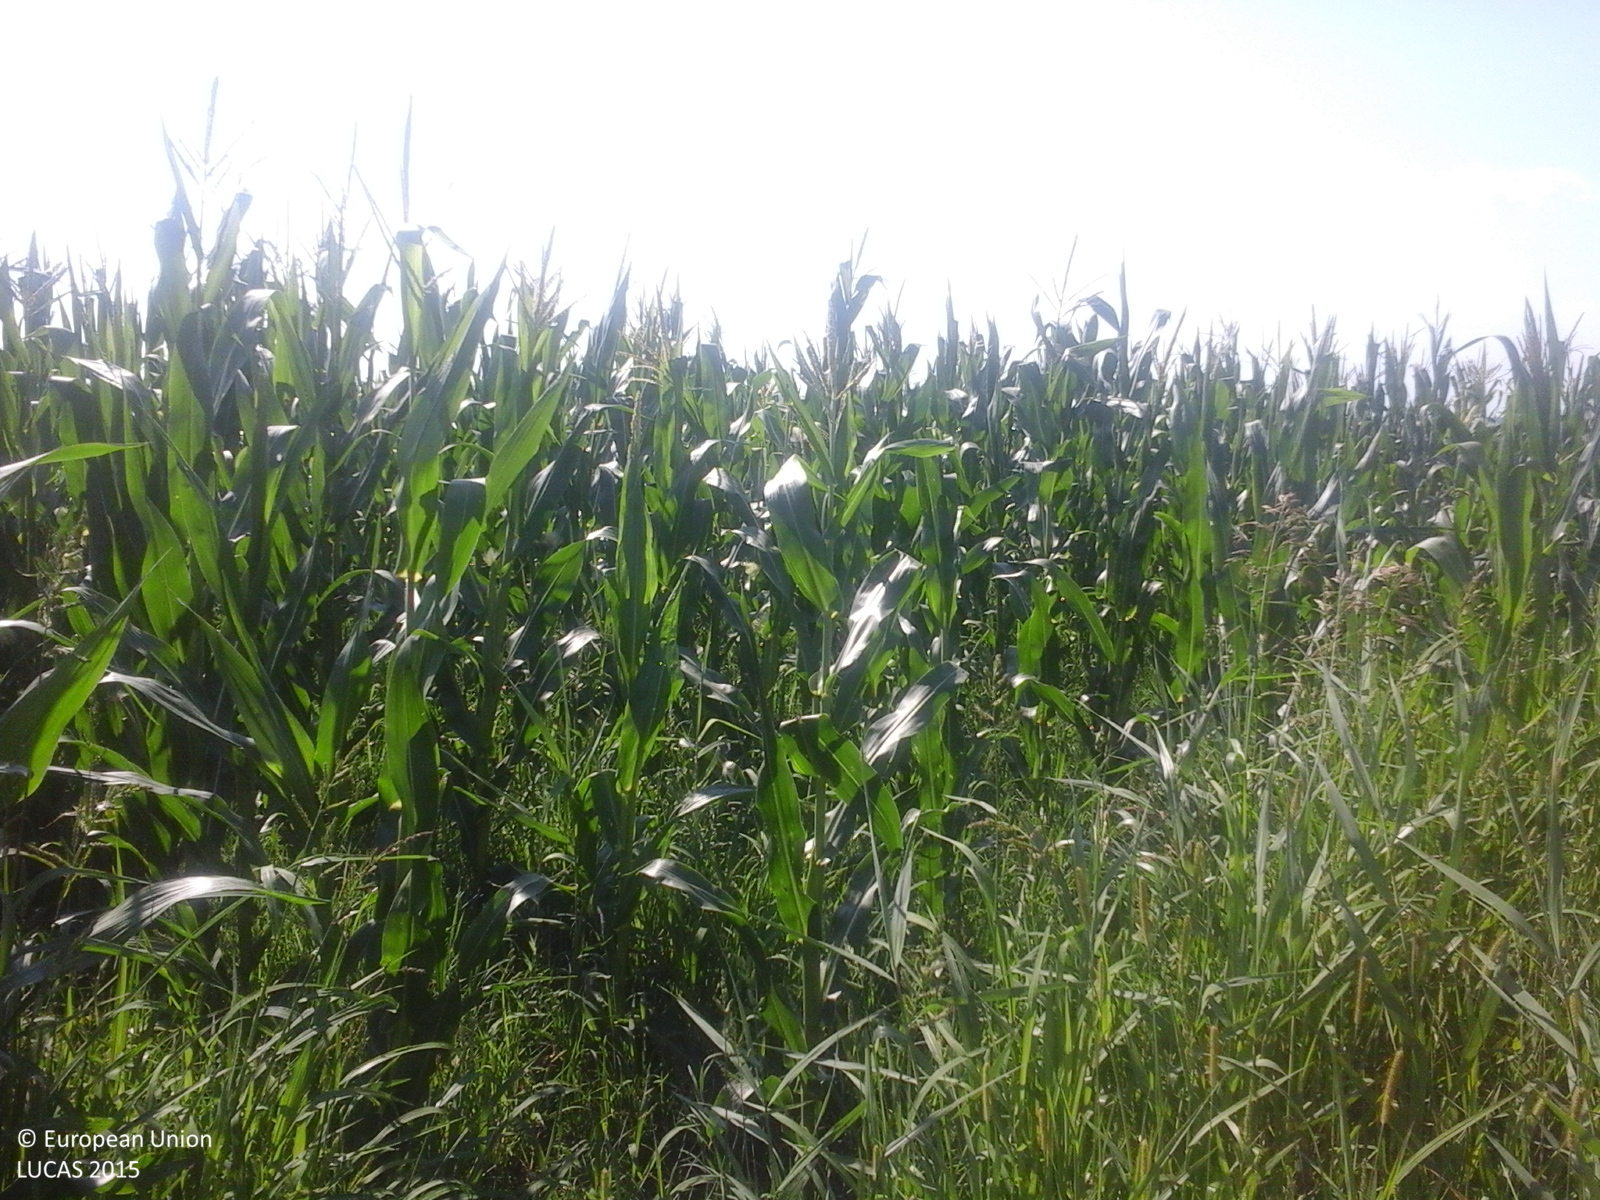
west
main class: Cropland
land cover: Maize
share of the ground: > 75 %
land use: Agriculture (excluding fallow land and kitchen gardens)
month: July
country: RO
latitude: 44.6556
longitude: 24.2804
